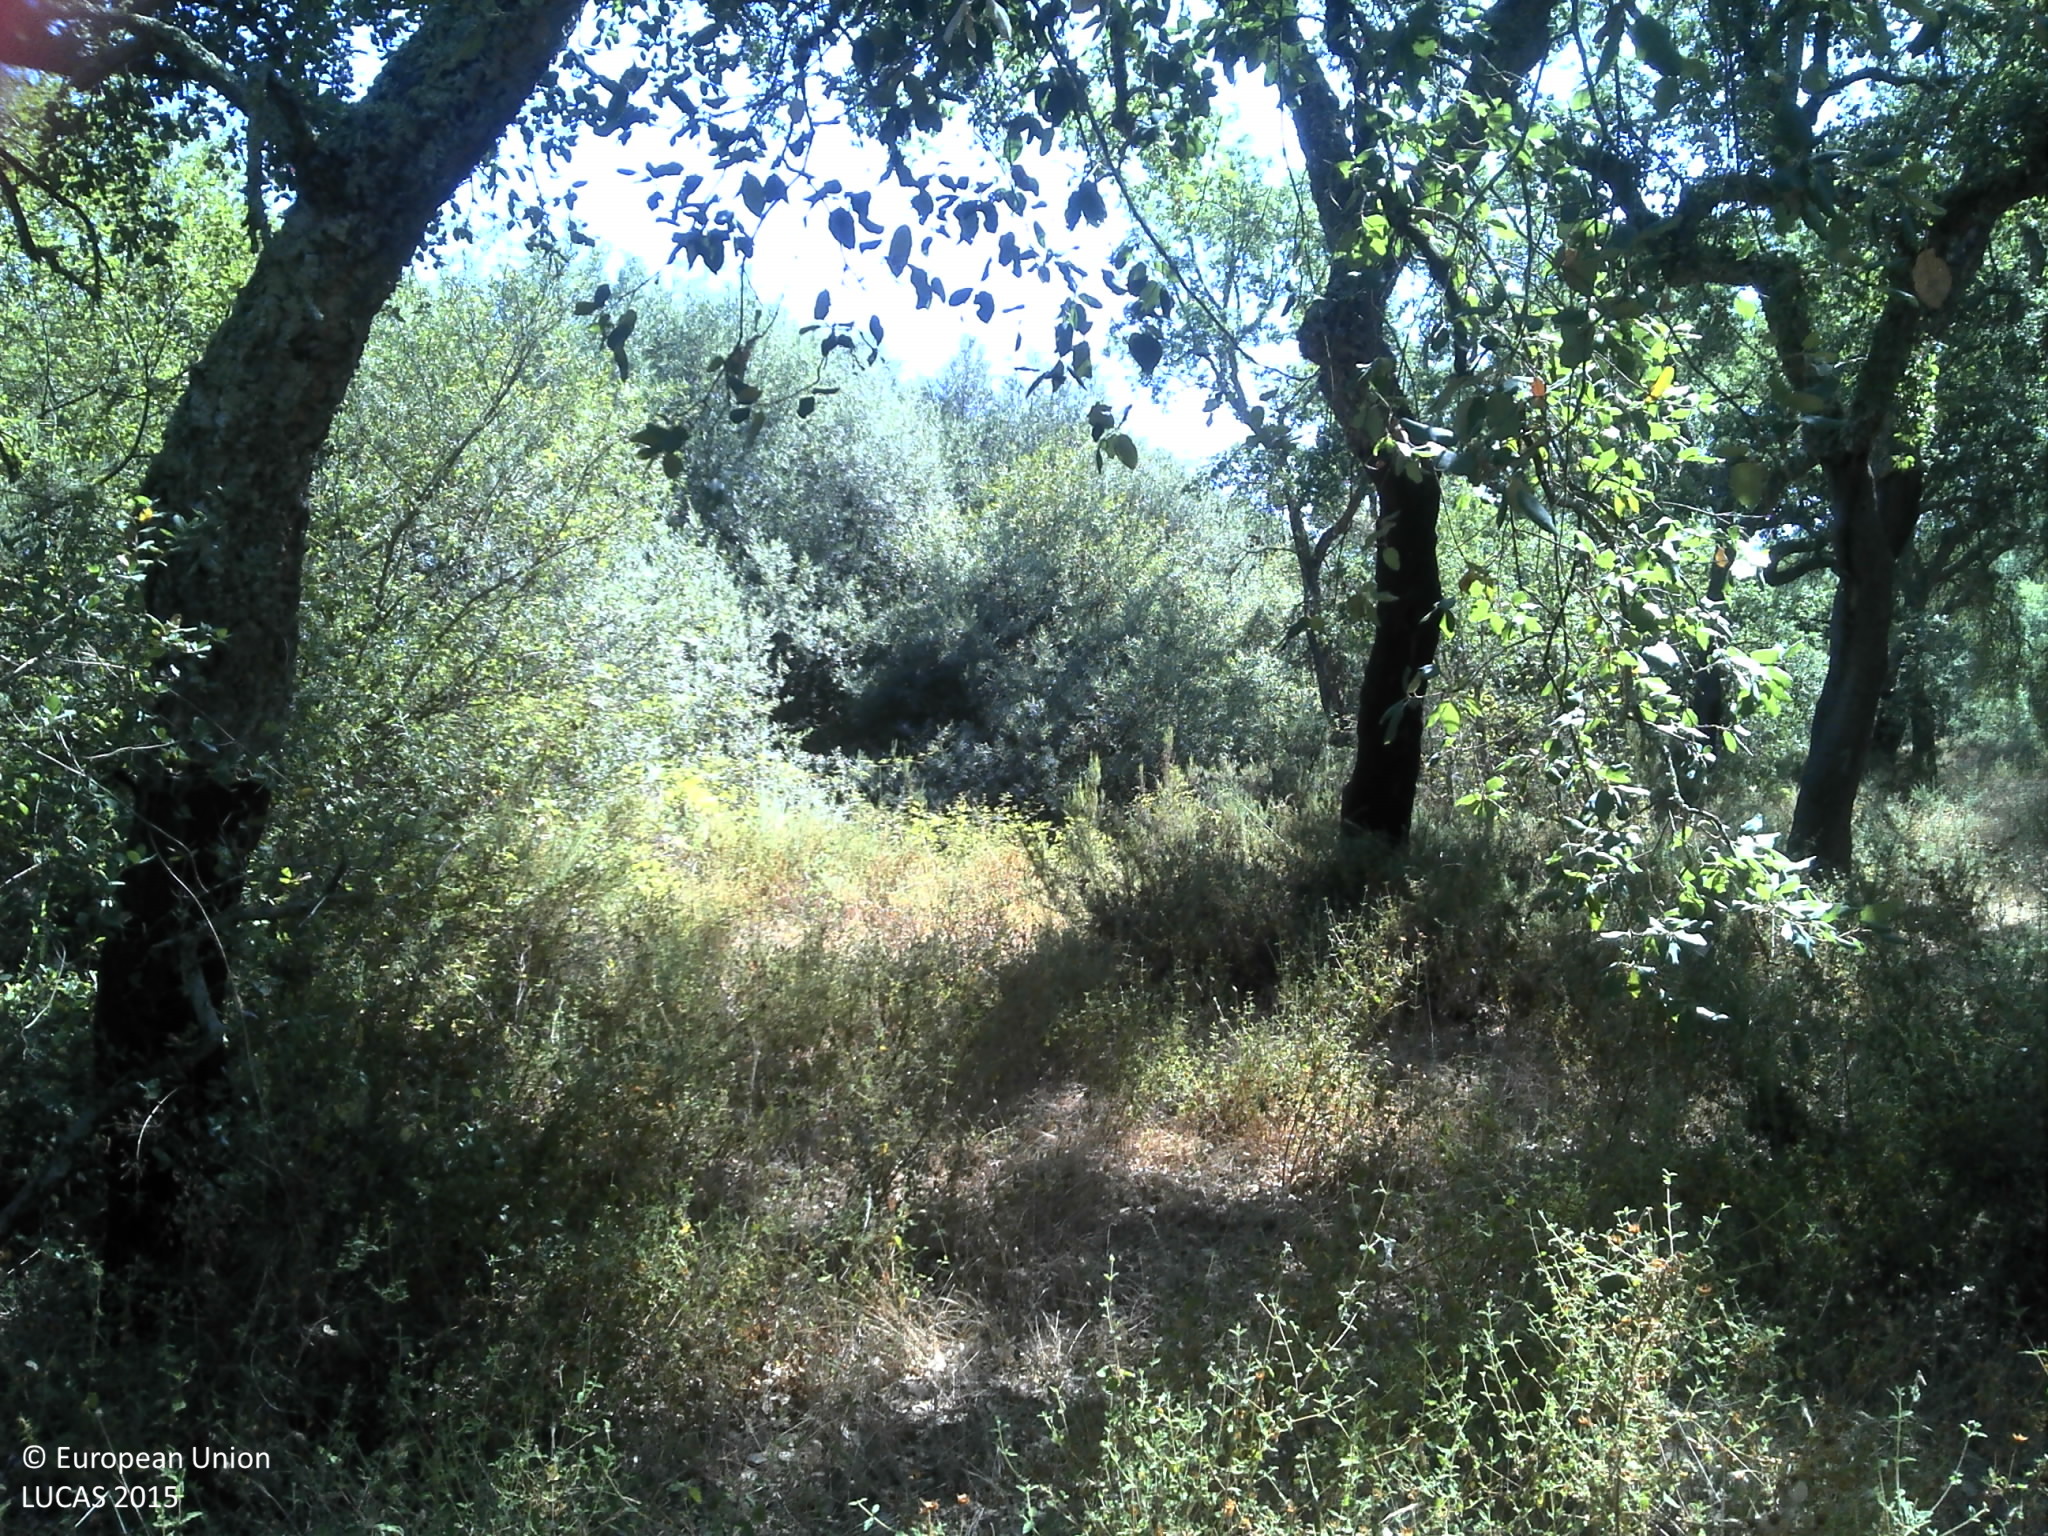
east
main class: Woodland
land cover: Broadleaved woodland
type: broadleaved evergreen forest
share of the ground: 50 - 75 %
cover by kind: broadleaved forest trees 70 %, unconsolidated bare surface 15 %, herbaceous plants 10 %, shrubs 5 %
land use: Forestry
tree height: > 5 m
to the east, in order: Broadleaved woodland; Tracks; Broadleaved woodland
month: July
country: PT
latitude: 39.2438
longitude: -8.2400
